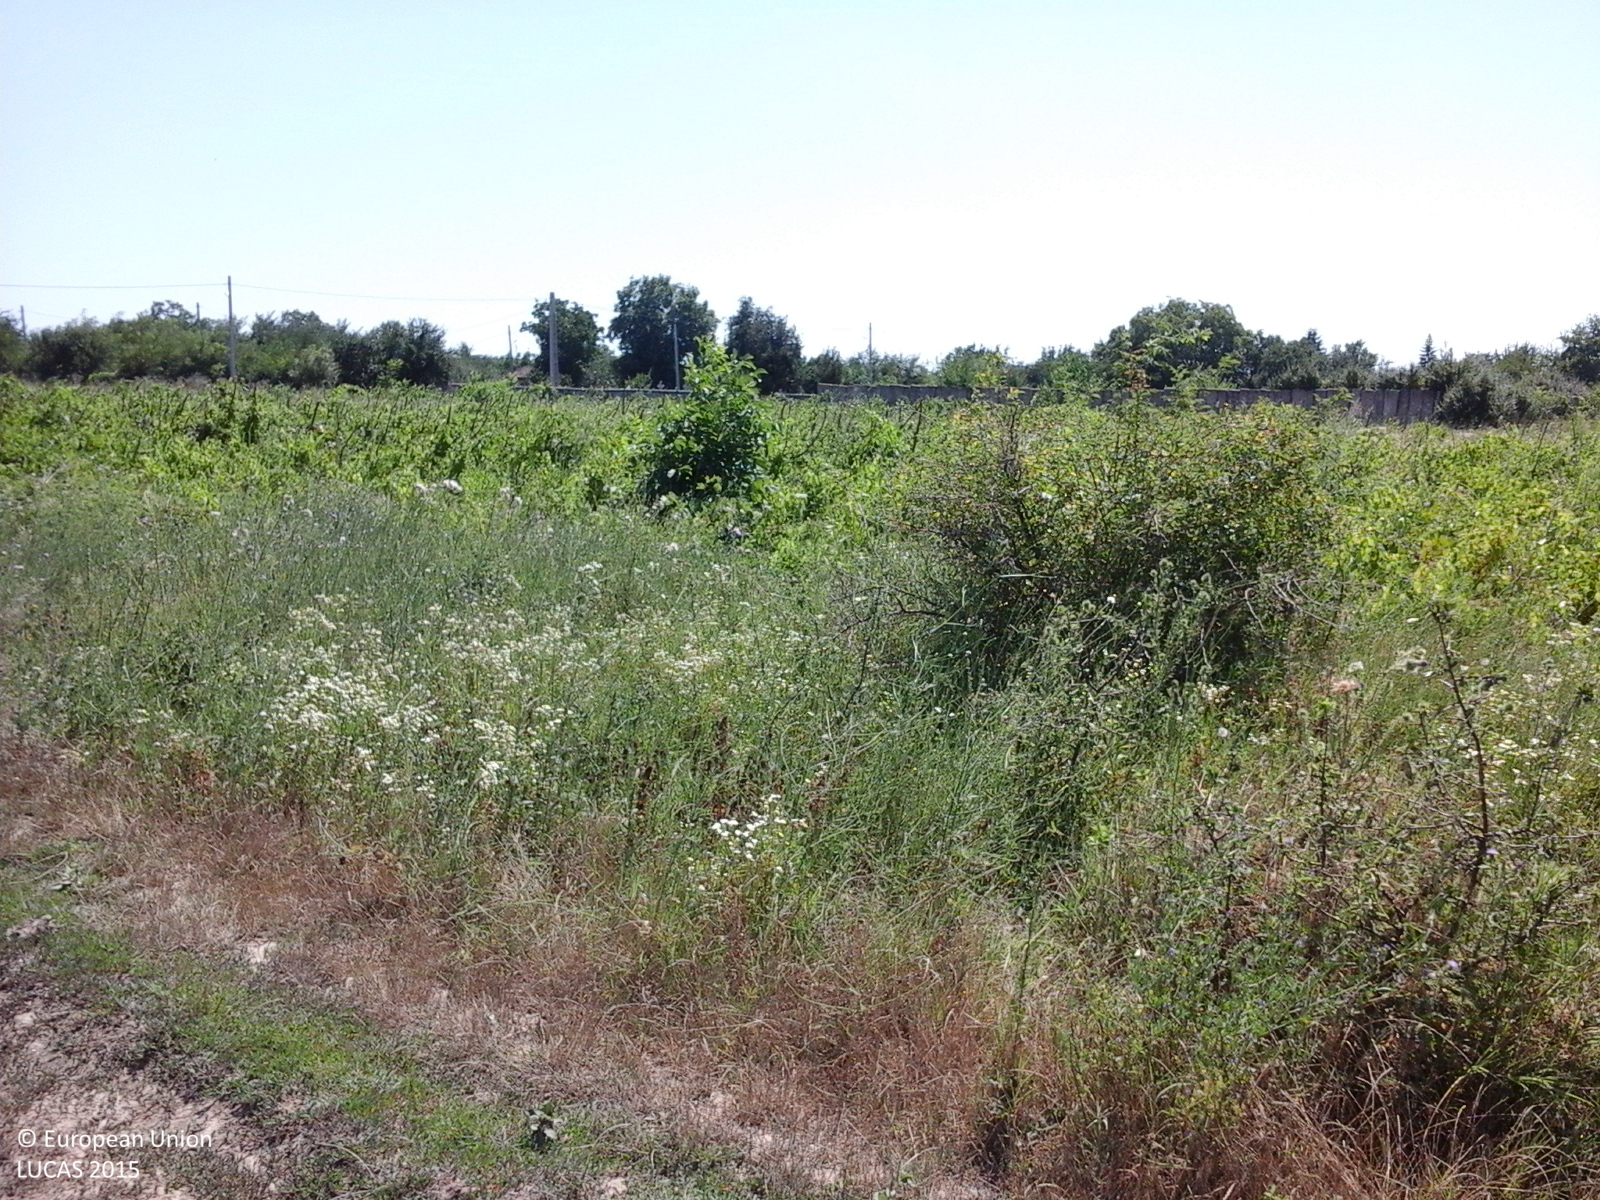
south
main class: Artificial land
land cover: Non built-up linear features
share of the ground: > 75 %
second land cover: Spontaneously vegetated surfaces
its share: 50 - 75 %
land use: Agriculture (excluding fallow land and kitchen gardens)
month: July
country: RO
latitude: 44.3174
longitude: 26.4236
